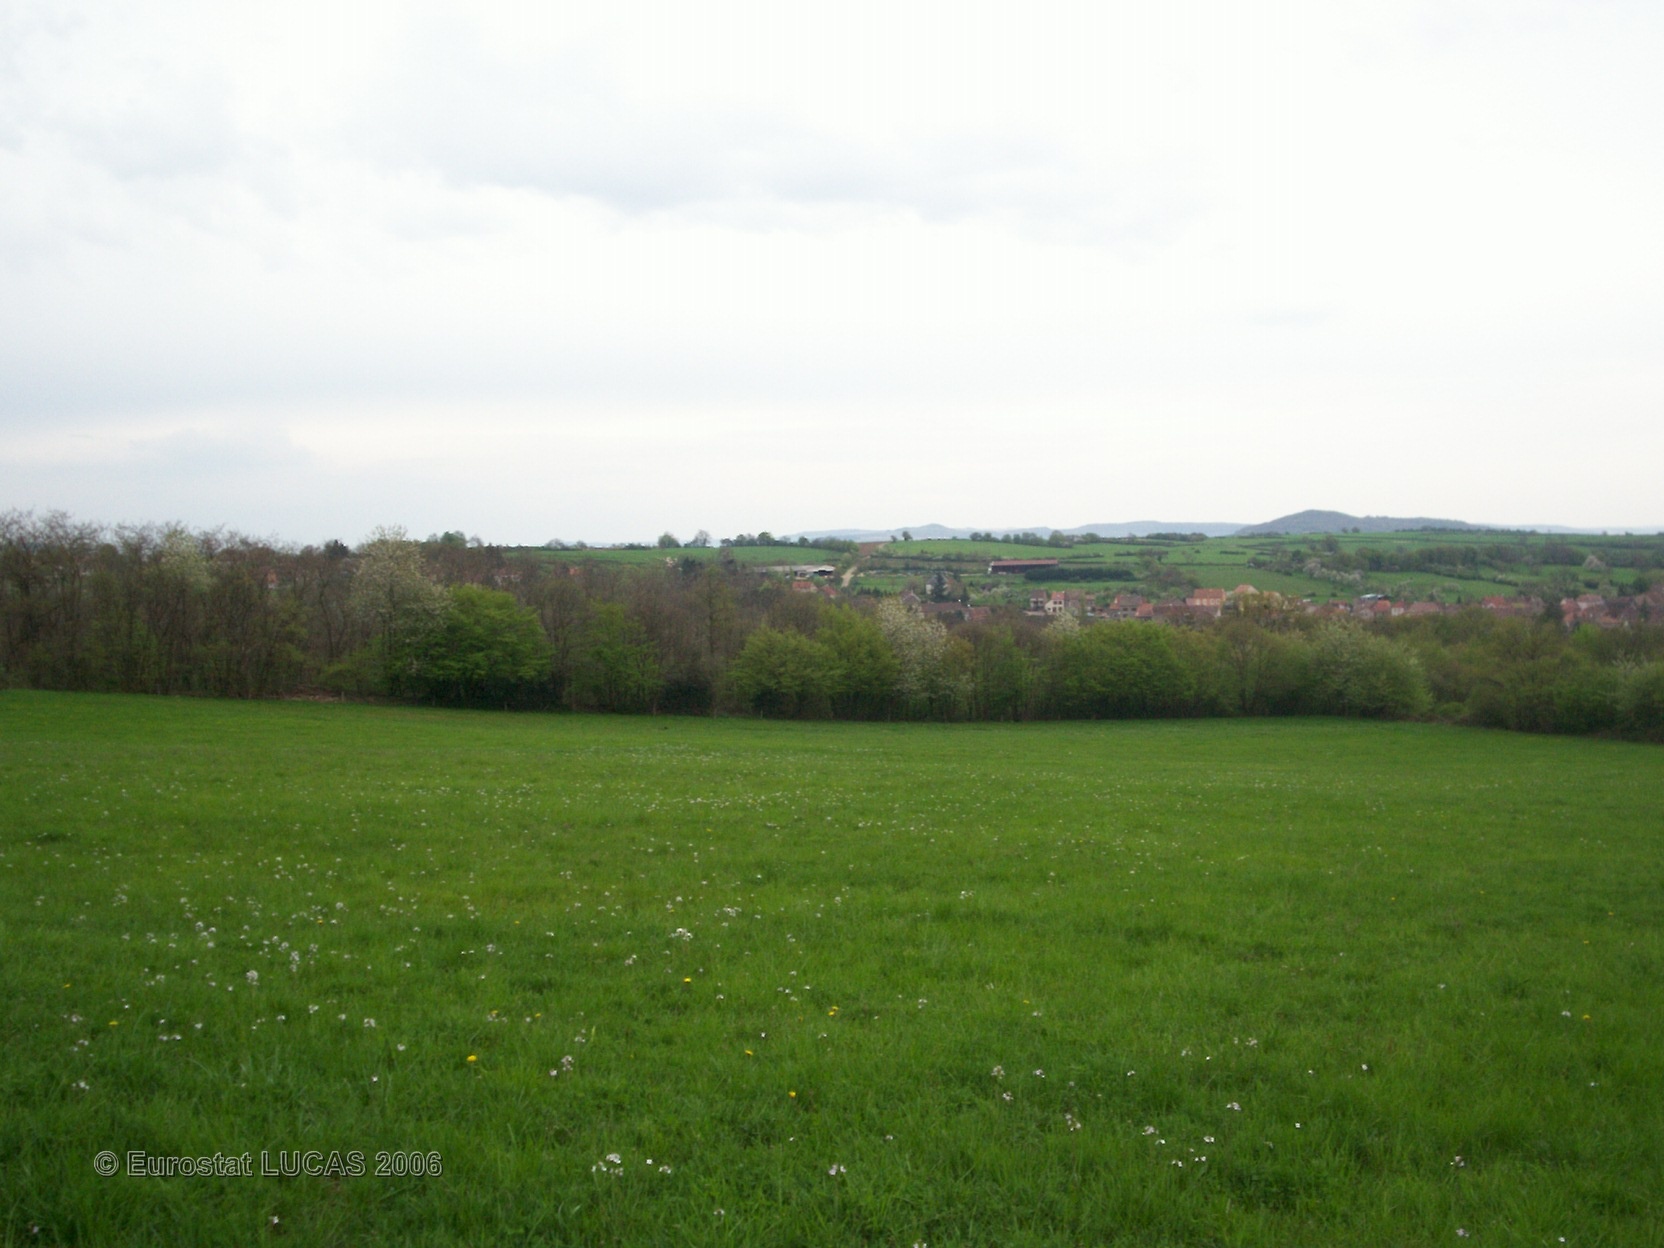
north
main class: Grassland
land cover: Grassland without tree/shrub cover
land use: Agriculture (excluding fallow land and kitchen gardens)
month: April
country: FR
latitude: 46.8317
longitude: 4.6651
